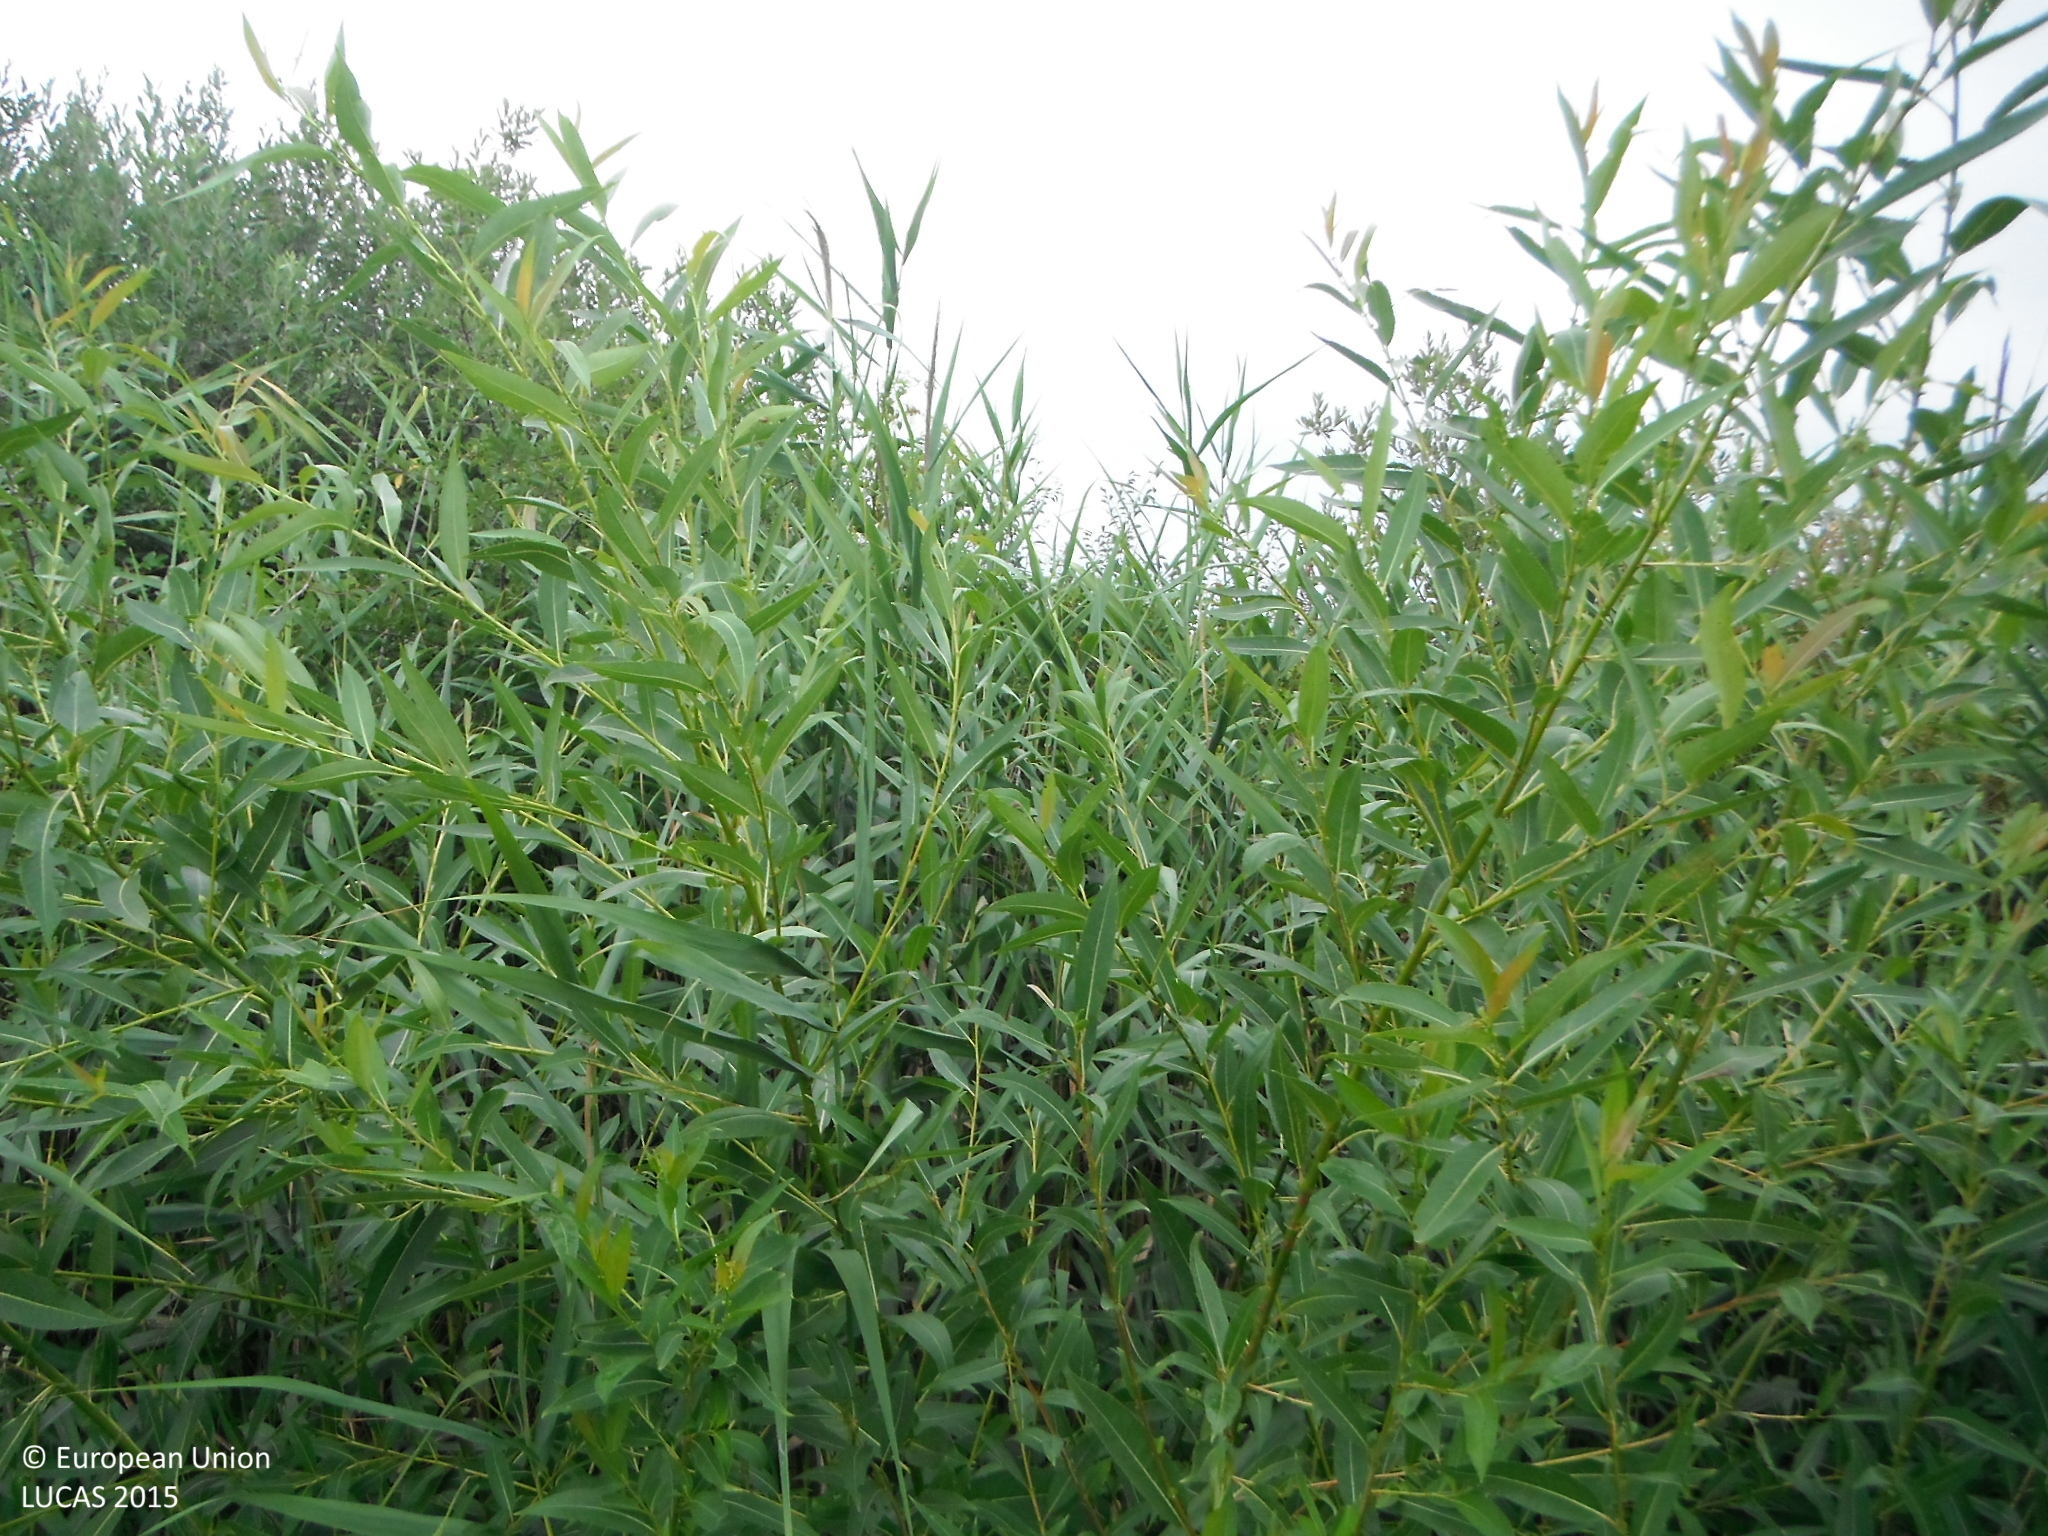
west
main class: Shrubland
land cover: Shrubland with sparse tree cover
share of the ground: > 75 %
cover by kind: shrubs 95 %, broadleaved forest trees 5 %
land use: Semi-natural and natural areas not in use
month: July
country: SK
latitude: 48.6352
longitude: 18.2796
